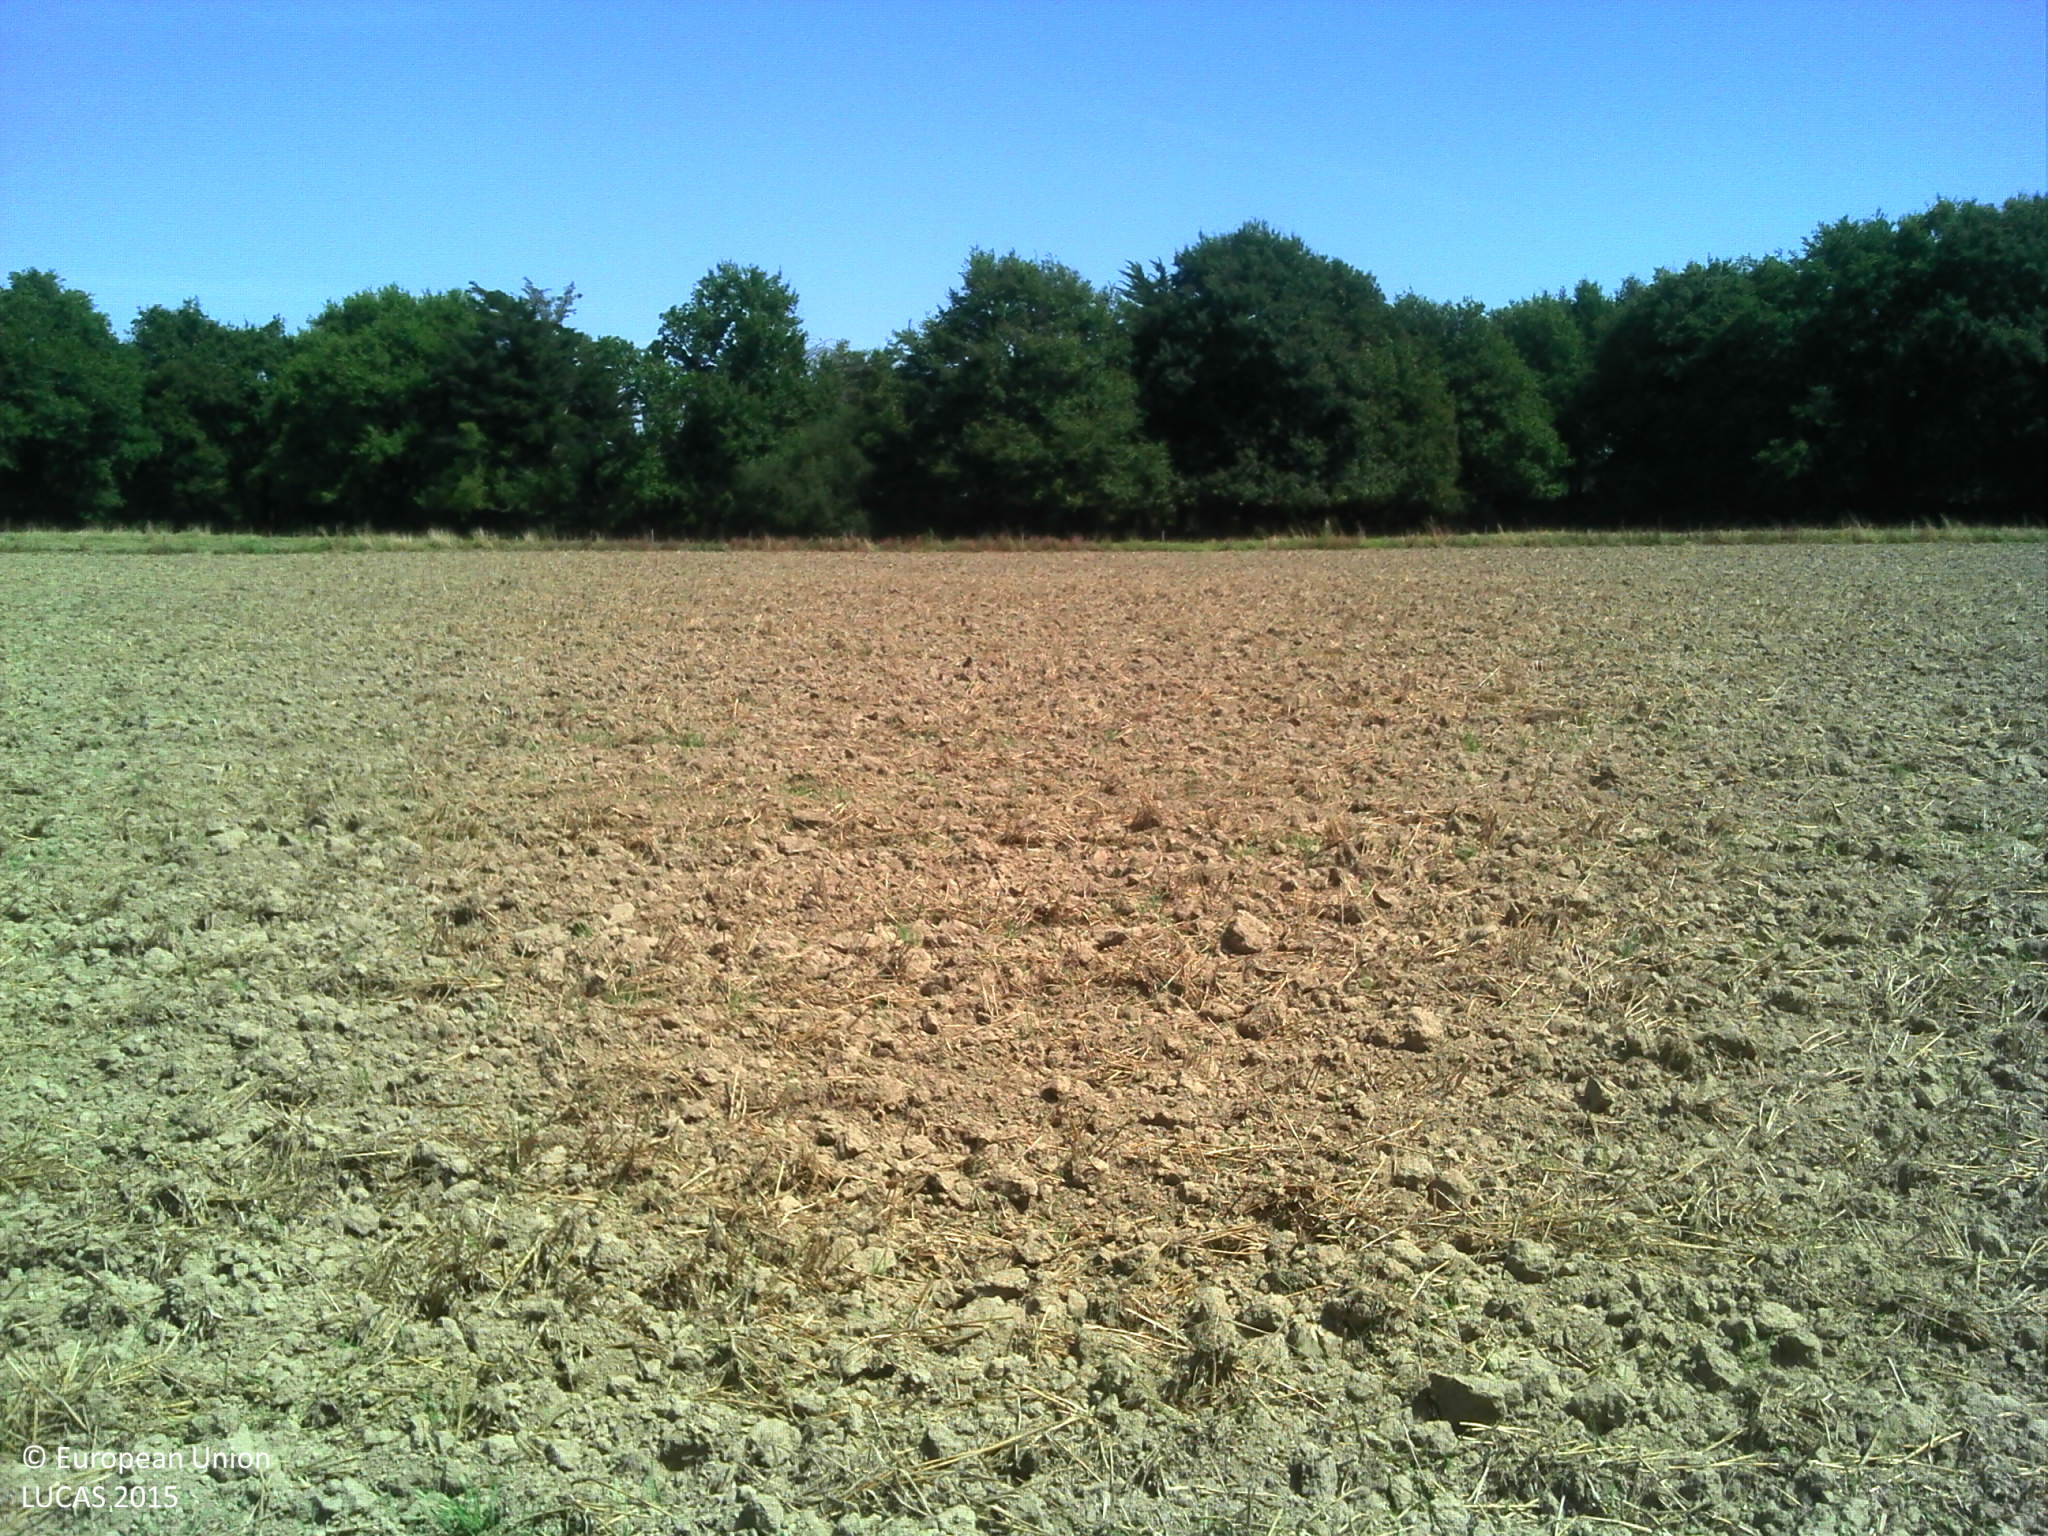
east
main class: Cropland
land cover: Common wheat
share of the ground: > 75 %
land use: Agriculture (excluding fallow land and kitchen gardens)
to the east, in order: Common wheat; Fences; Grassland without tree/shrub cover; Broadleaved woodland; Fences; Grassland with sparse tree/shrub cover; Inland fresh water bodies; Lines of trees; Tracks; Lines of trees; Ditches and canals; Common wheat
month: August
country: FR
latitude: 46.7544
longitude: -1.6001
